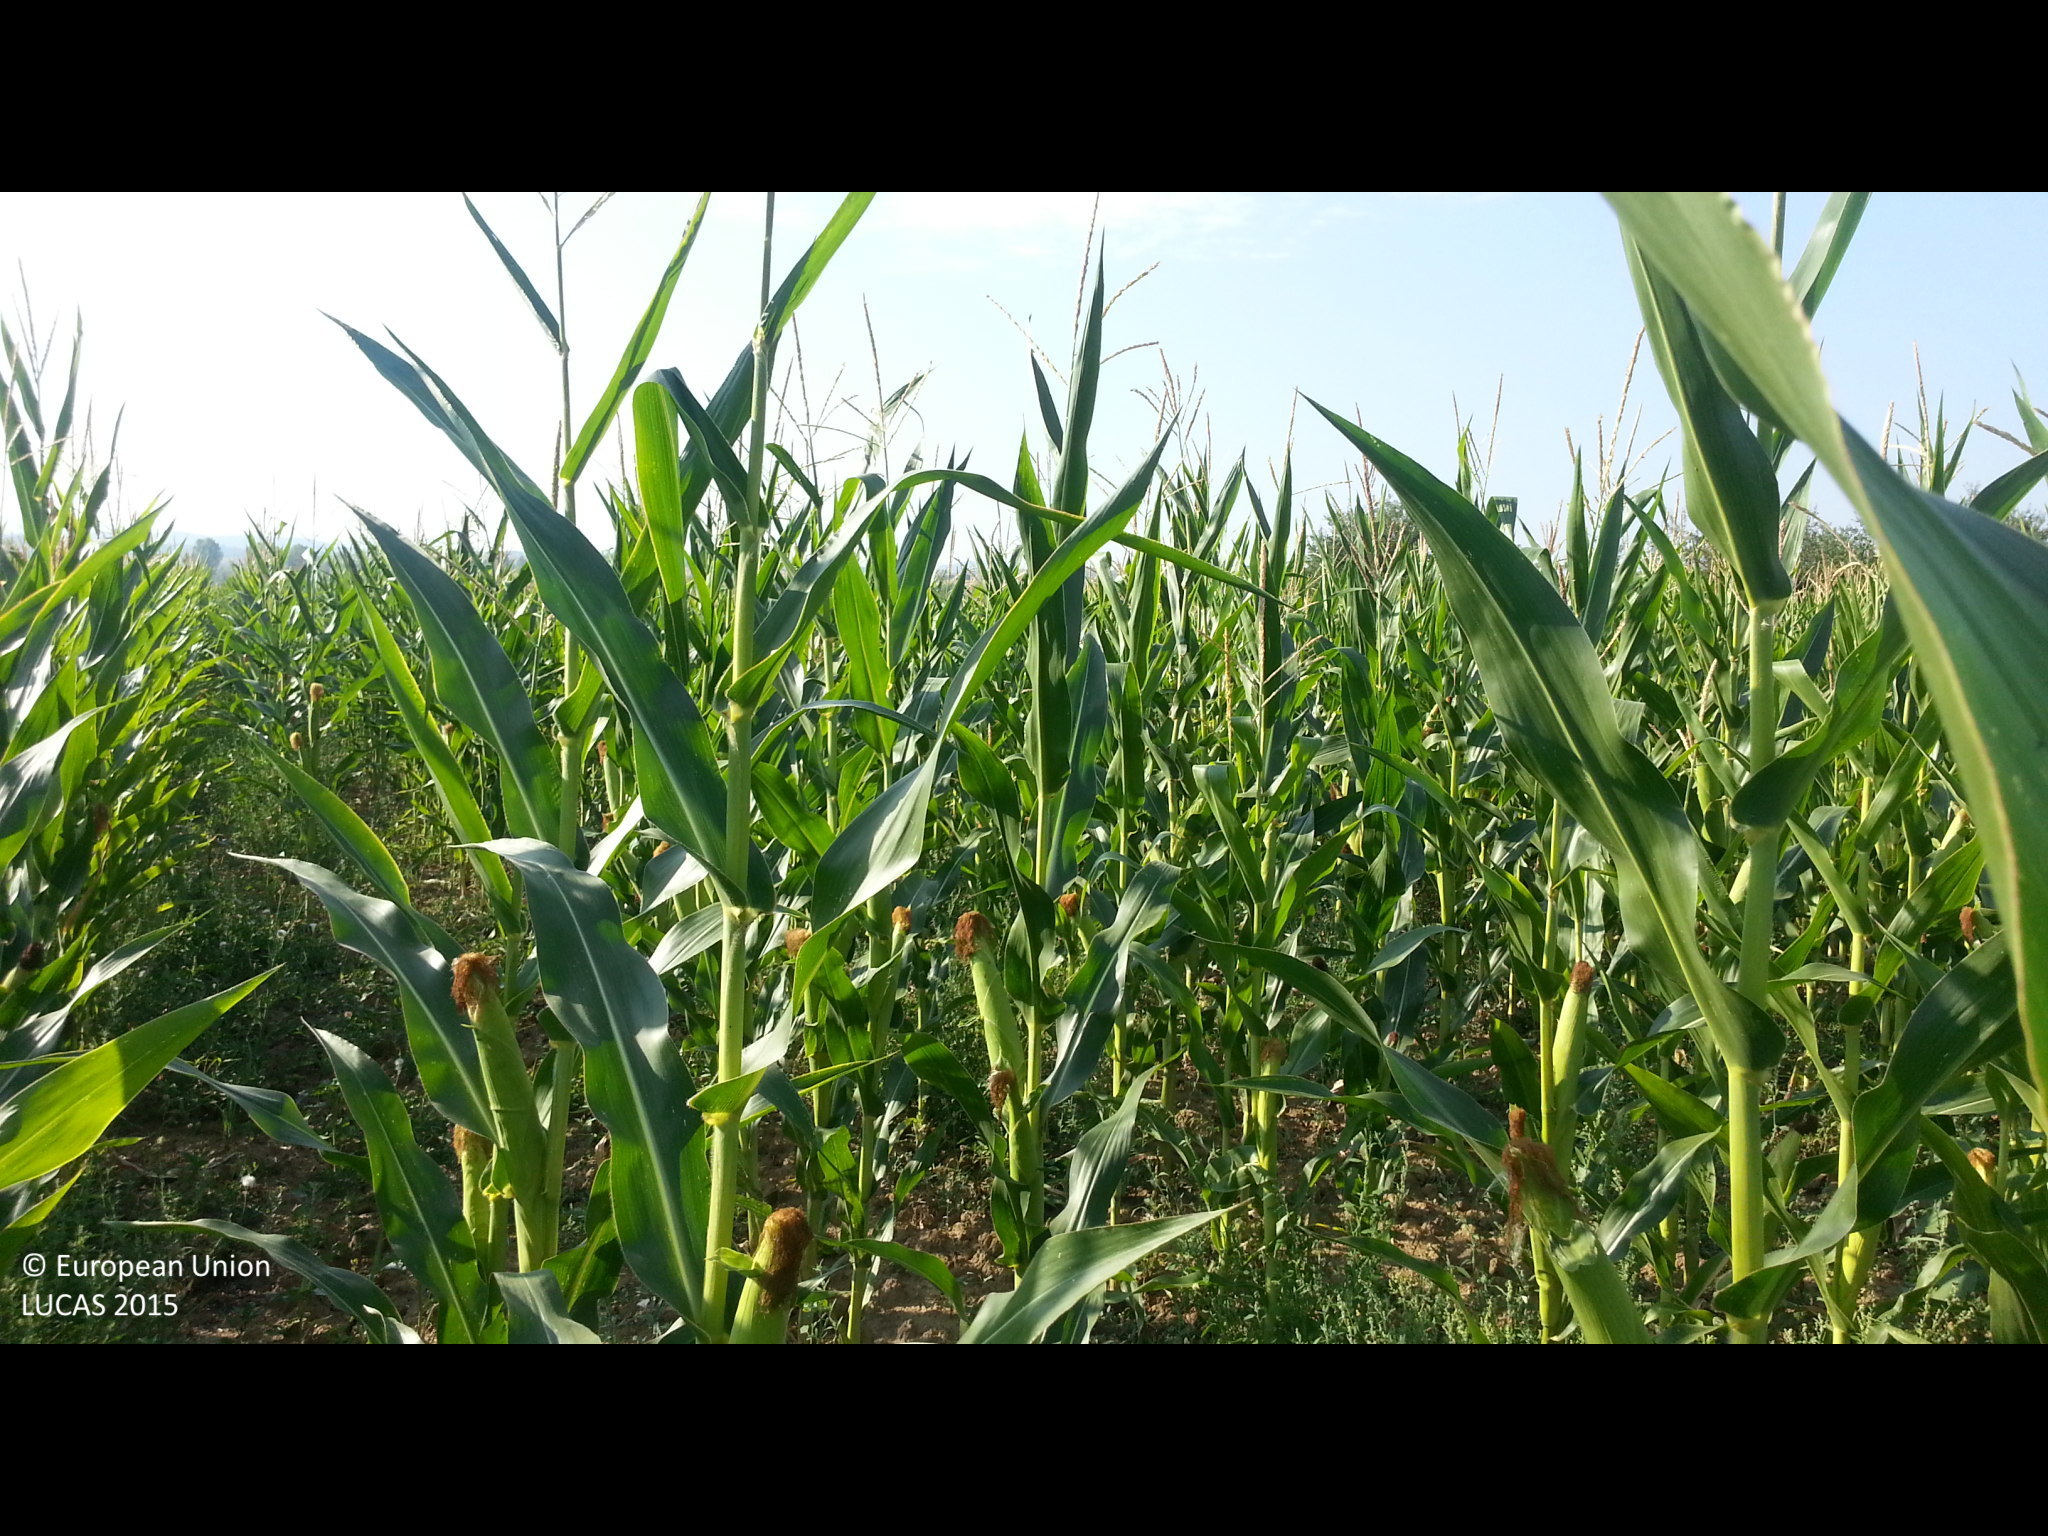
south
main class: Cropland
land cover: Maize
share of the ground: 50 - 75 %
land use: Agriculture (excluding fallow land and kitchen gardens)
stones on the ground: 10 - 25 %
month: August
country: BG
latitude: 42.2776
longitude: 22.7912
